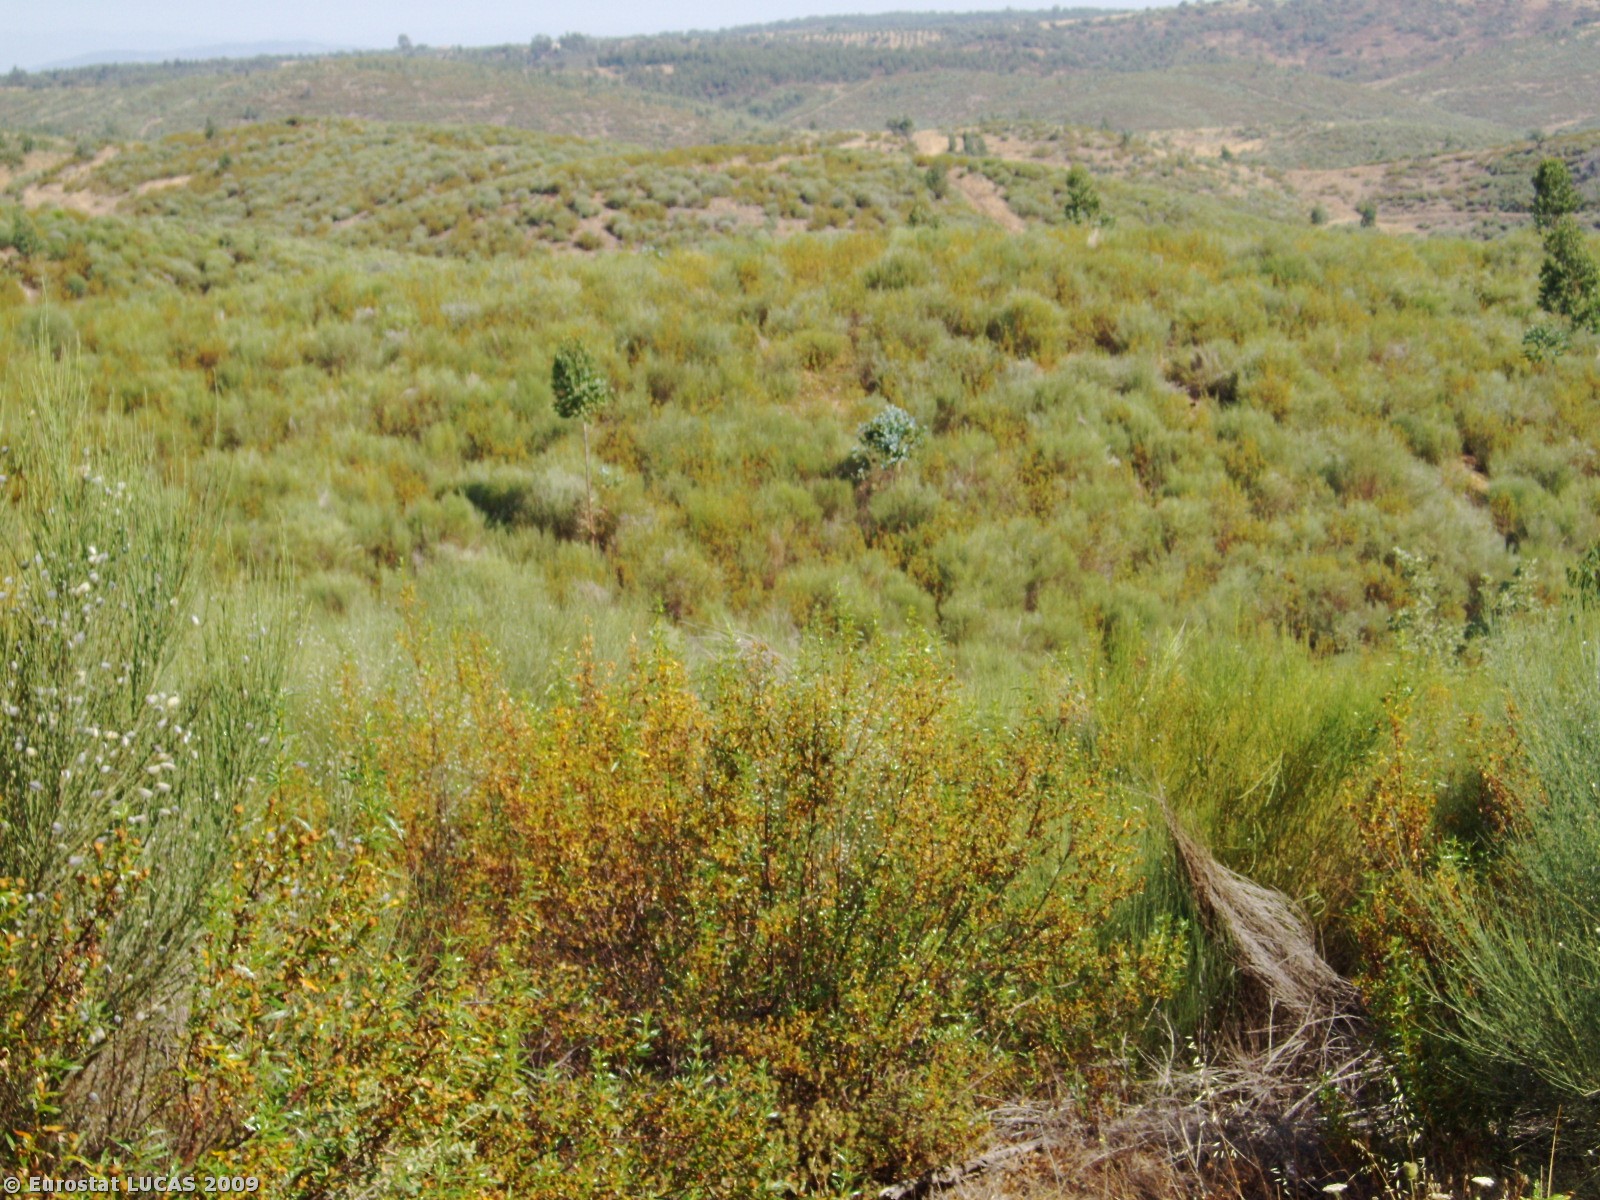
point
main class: Shrubland
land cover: Shrubland with sparse tree cover
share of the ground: > 75 %
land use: Unused
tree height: > 5 m
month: June
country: PT
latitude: 39.9848
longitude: -7.2282
